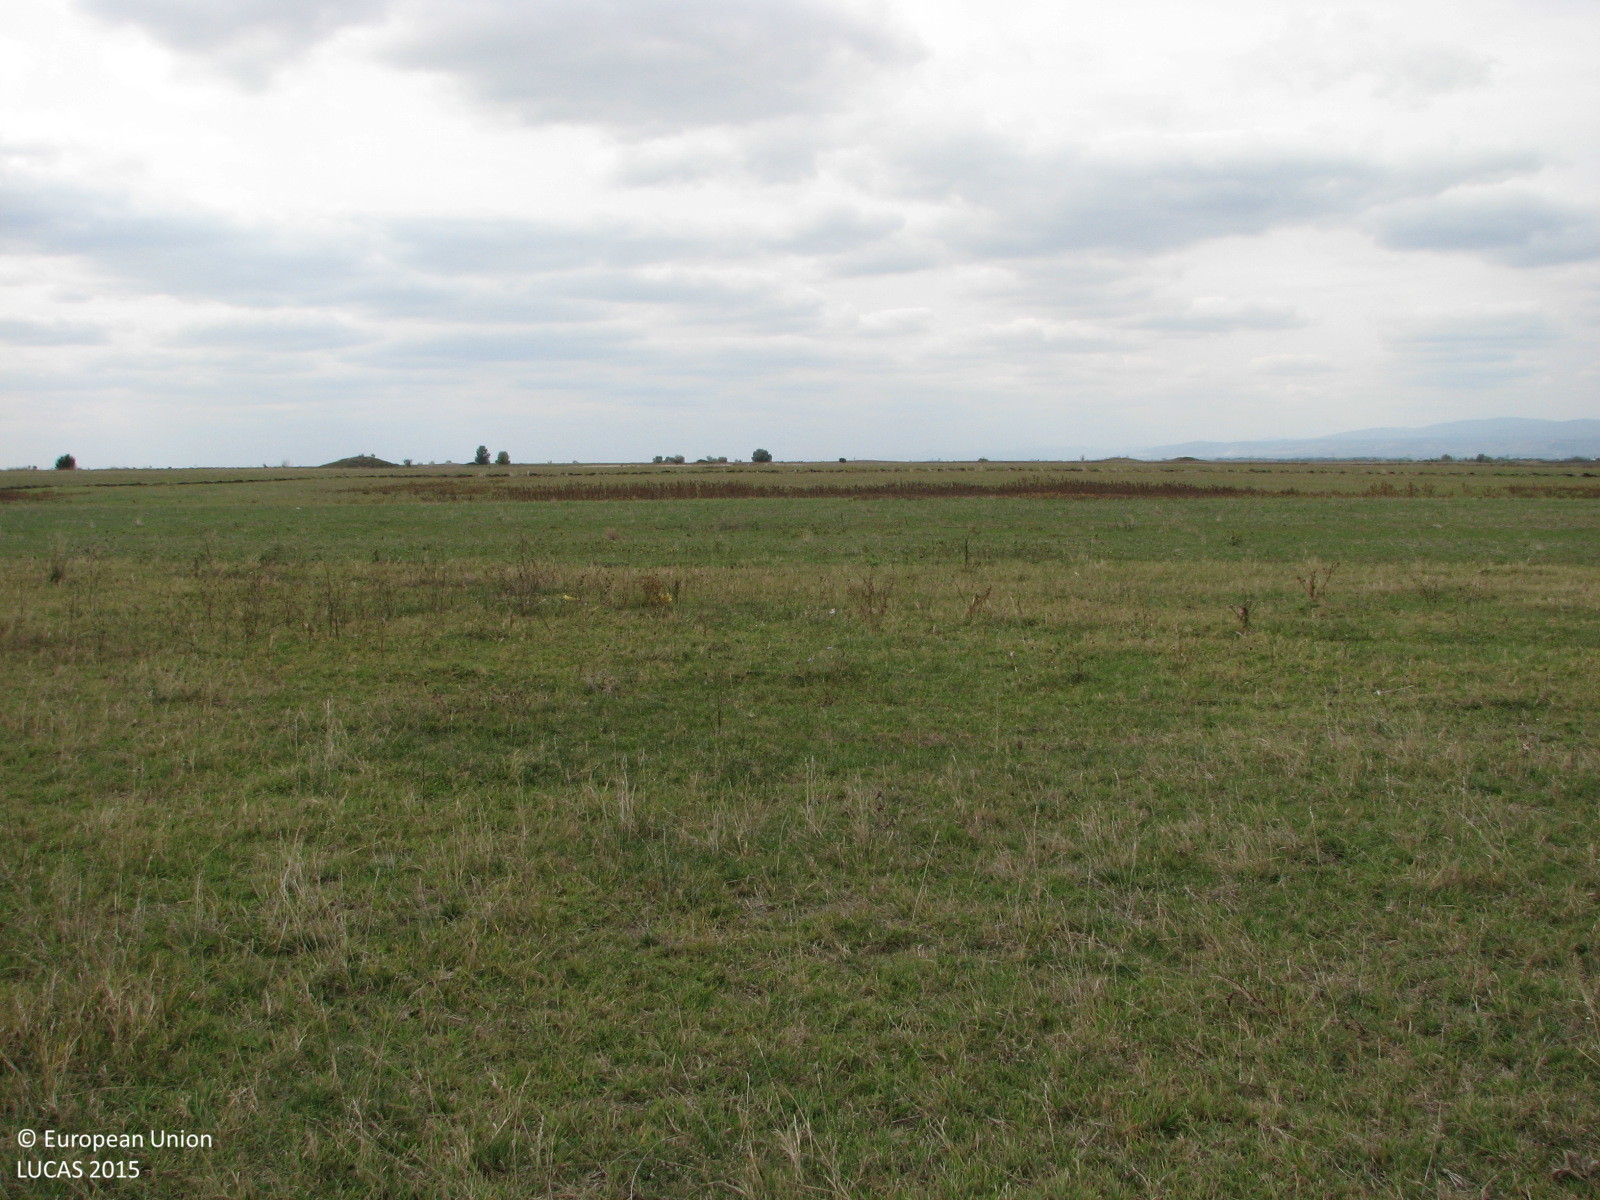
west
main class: Grassland
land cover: Grassland without tree/shrub cover
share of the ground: > 75 %
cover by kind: herbaceous plants 100 %
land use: Agriculture (excluding fallow land and kitchen gardens)
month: October
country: BG
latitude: 42.4943
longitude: 26.1076
